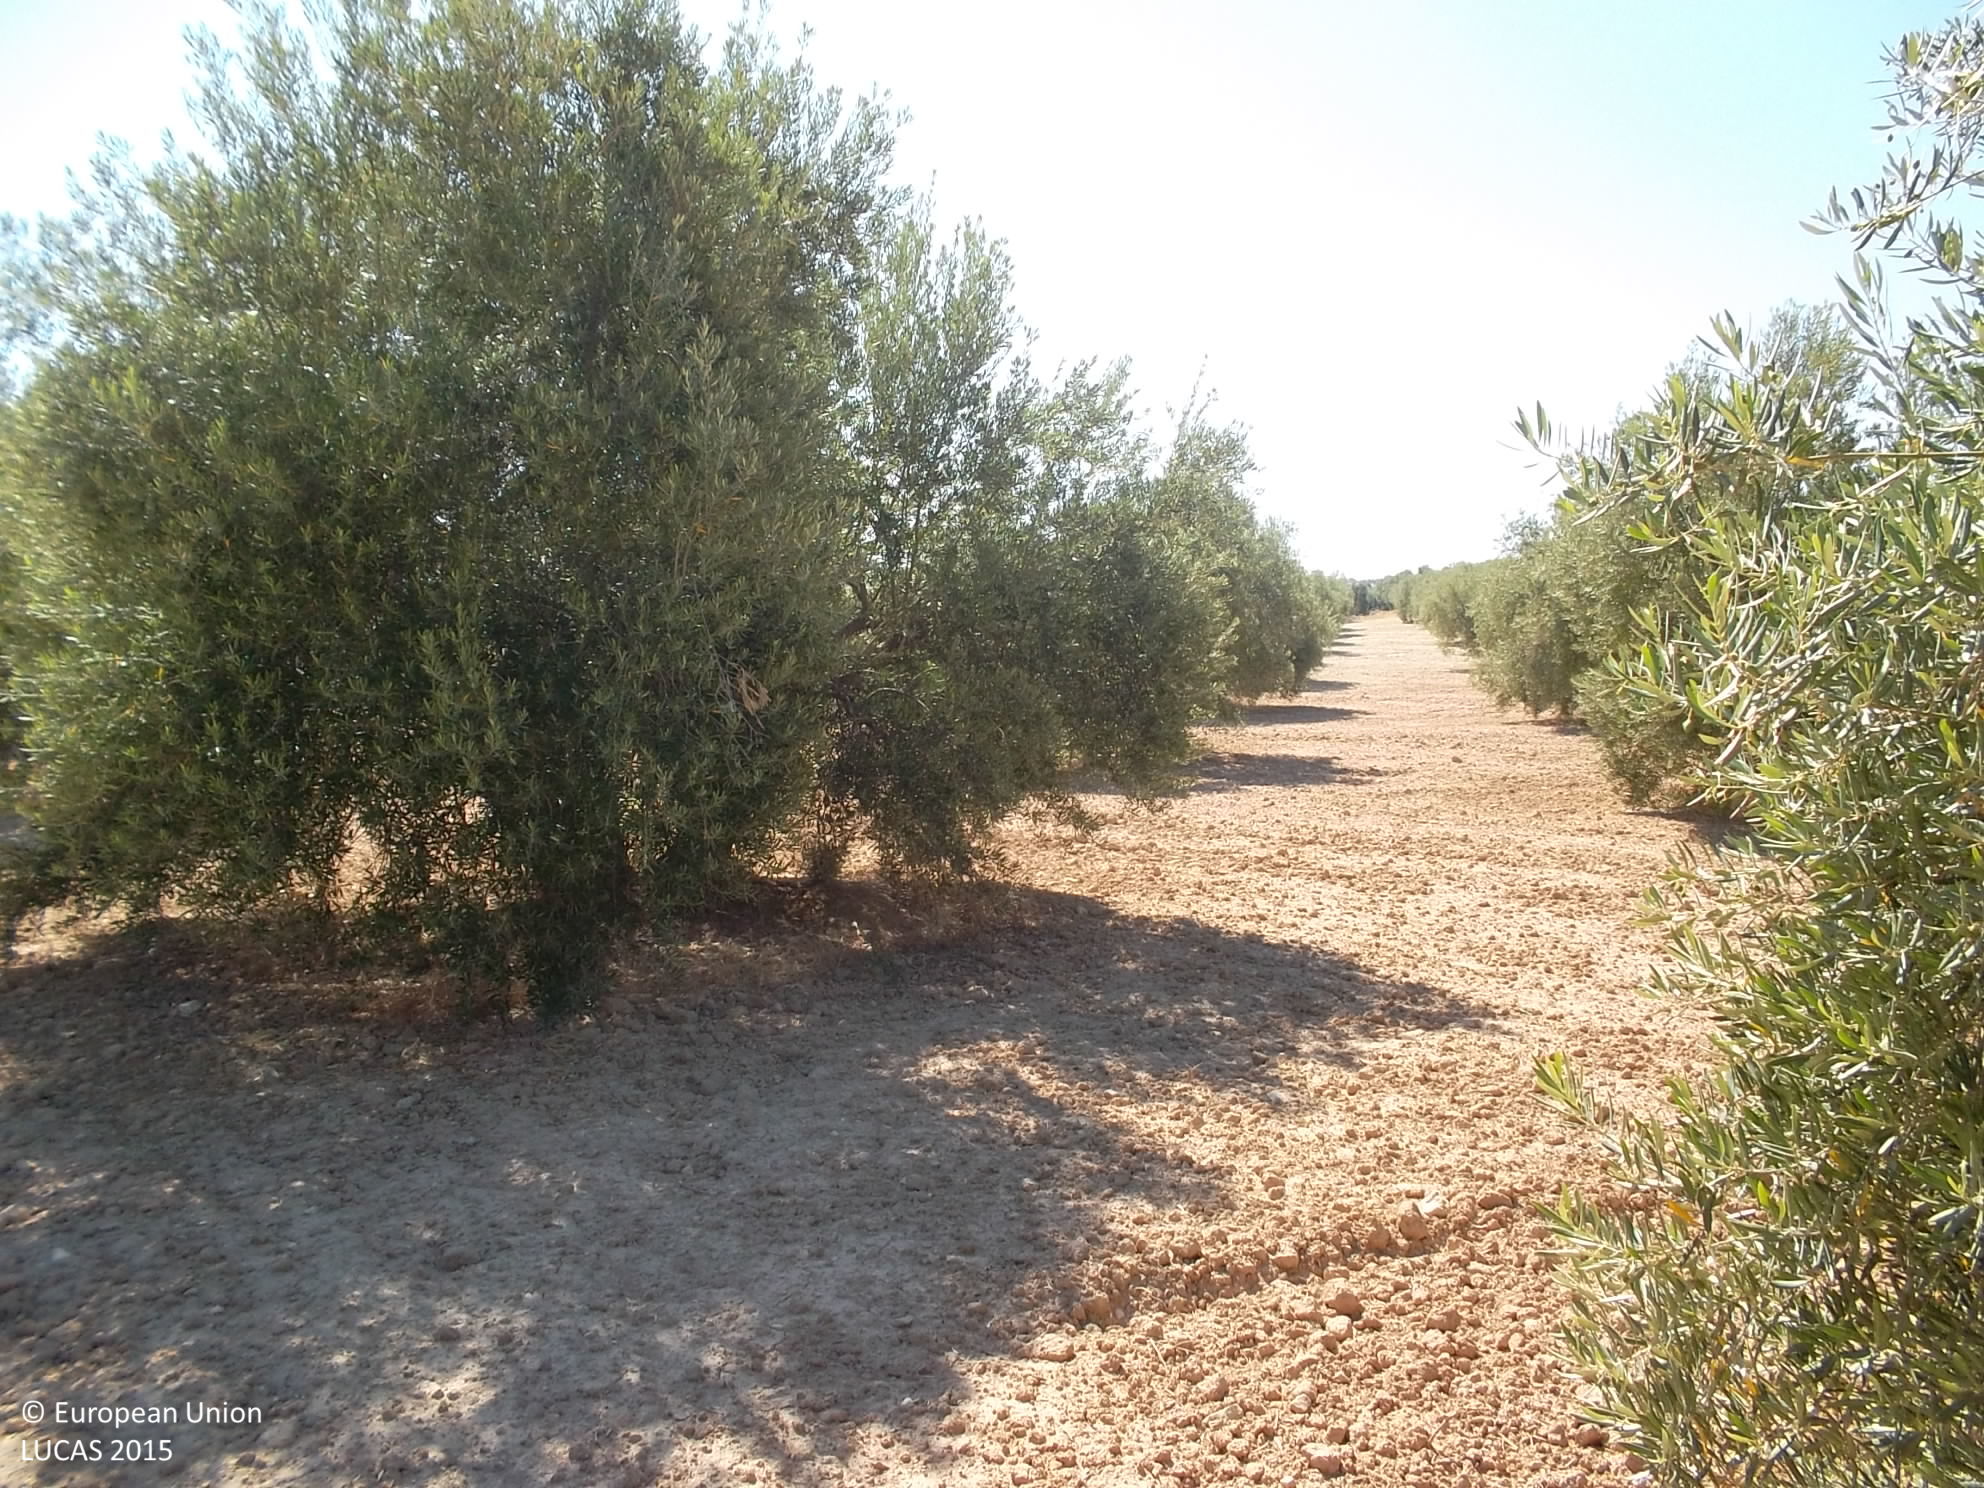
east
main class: Cropland
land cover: Olive groves
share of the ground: 25 - 50 %
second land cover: Other bare soil
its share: > 75 %
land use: Agriculture (excluding fallow land and kitchen gardens)
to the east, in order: Olive groves; Other bare soil; Tracks; Olive groves
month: June
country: ES
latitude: 37.8507
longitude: -3.3283
